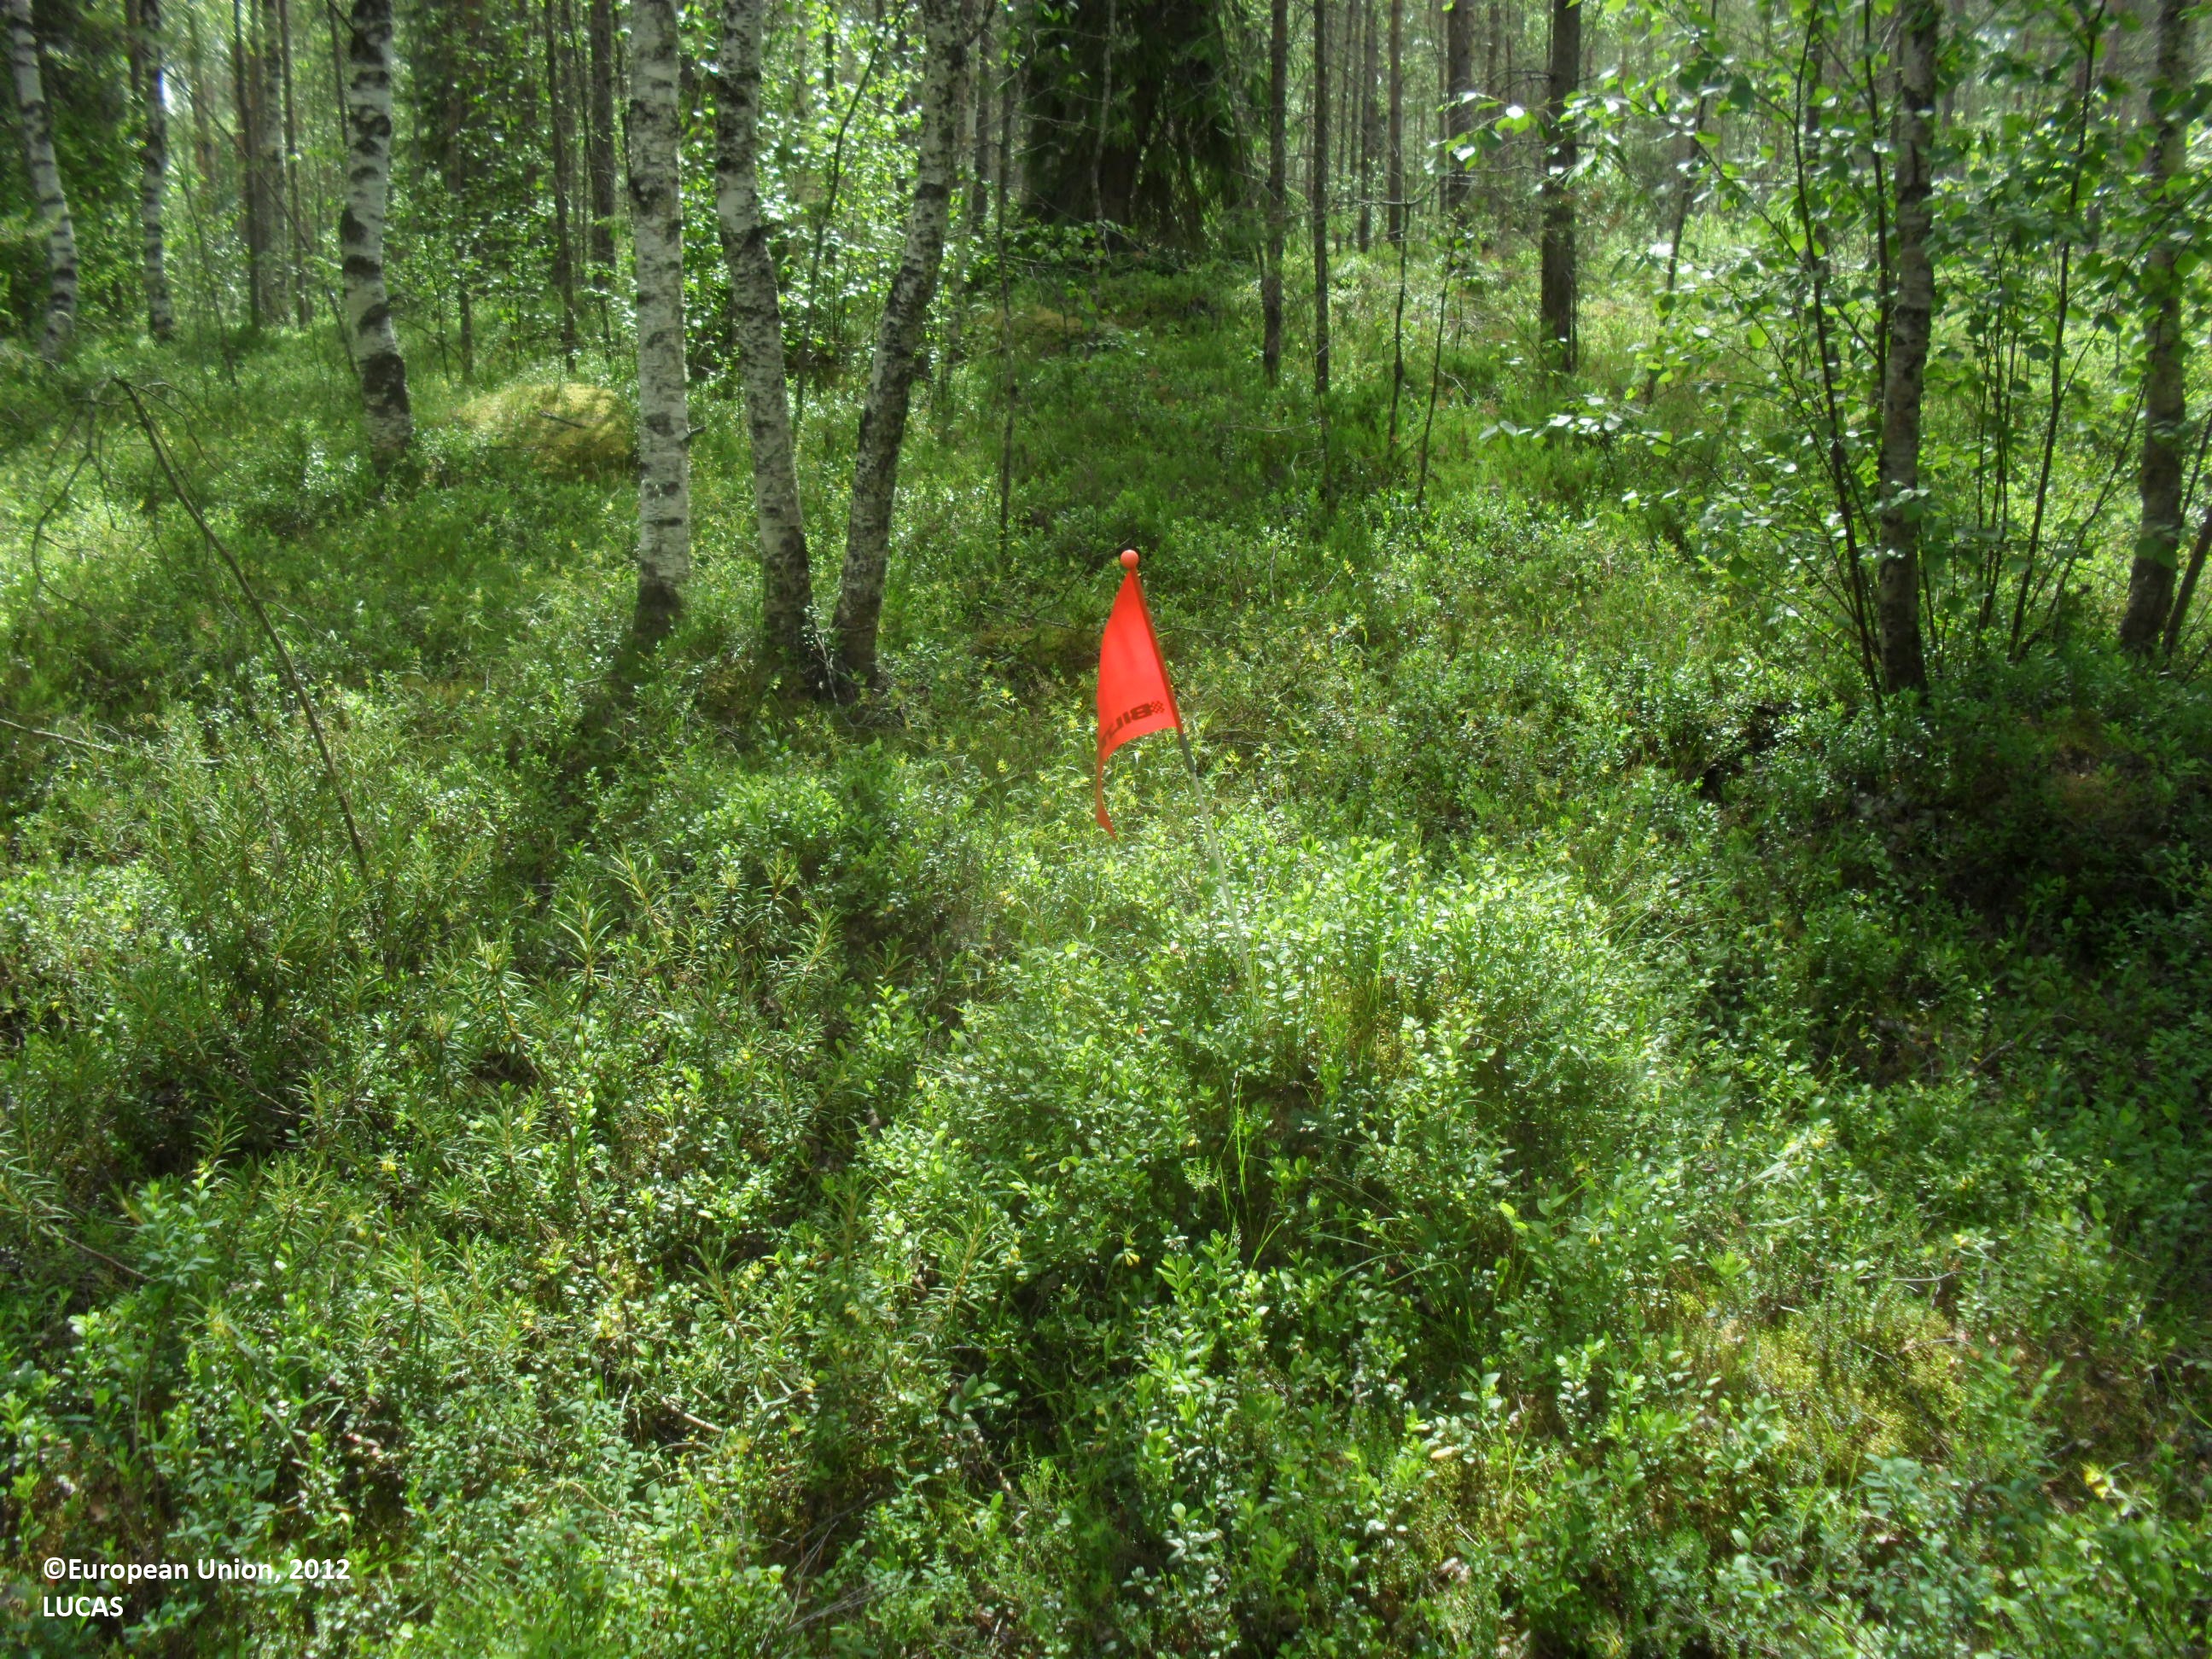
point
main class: Woodland
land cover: Other mixed woodland
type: boreal forest
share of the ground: 50 - 75 %
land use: Forestry
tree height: > 5 m
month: July
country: FI
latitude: 63.5797
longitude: 23.9069
